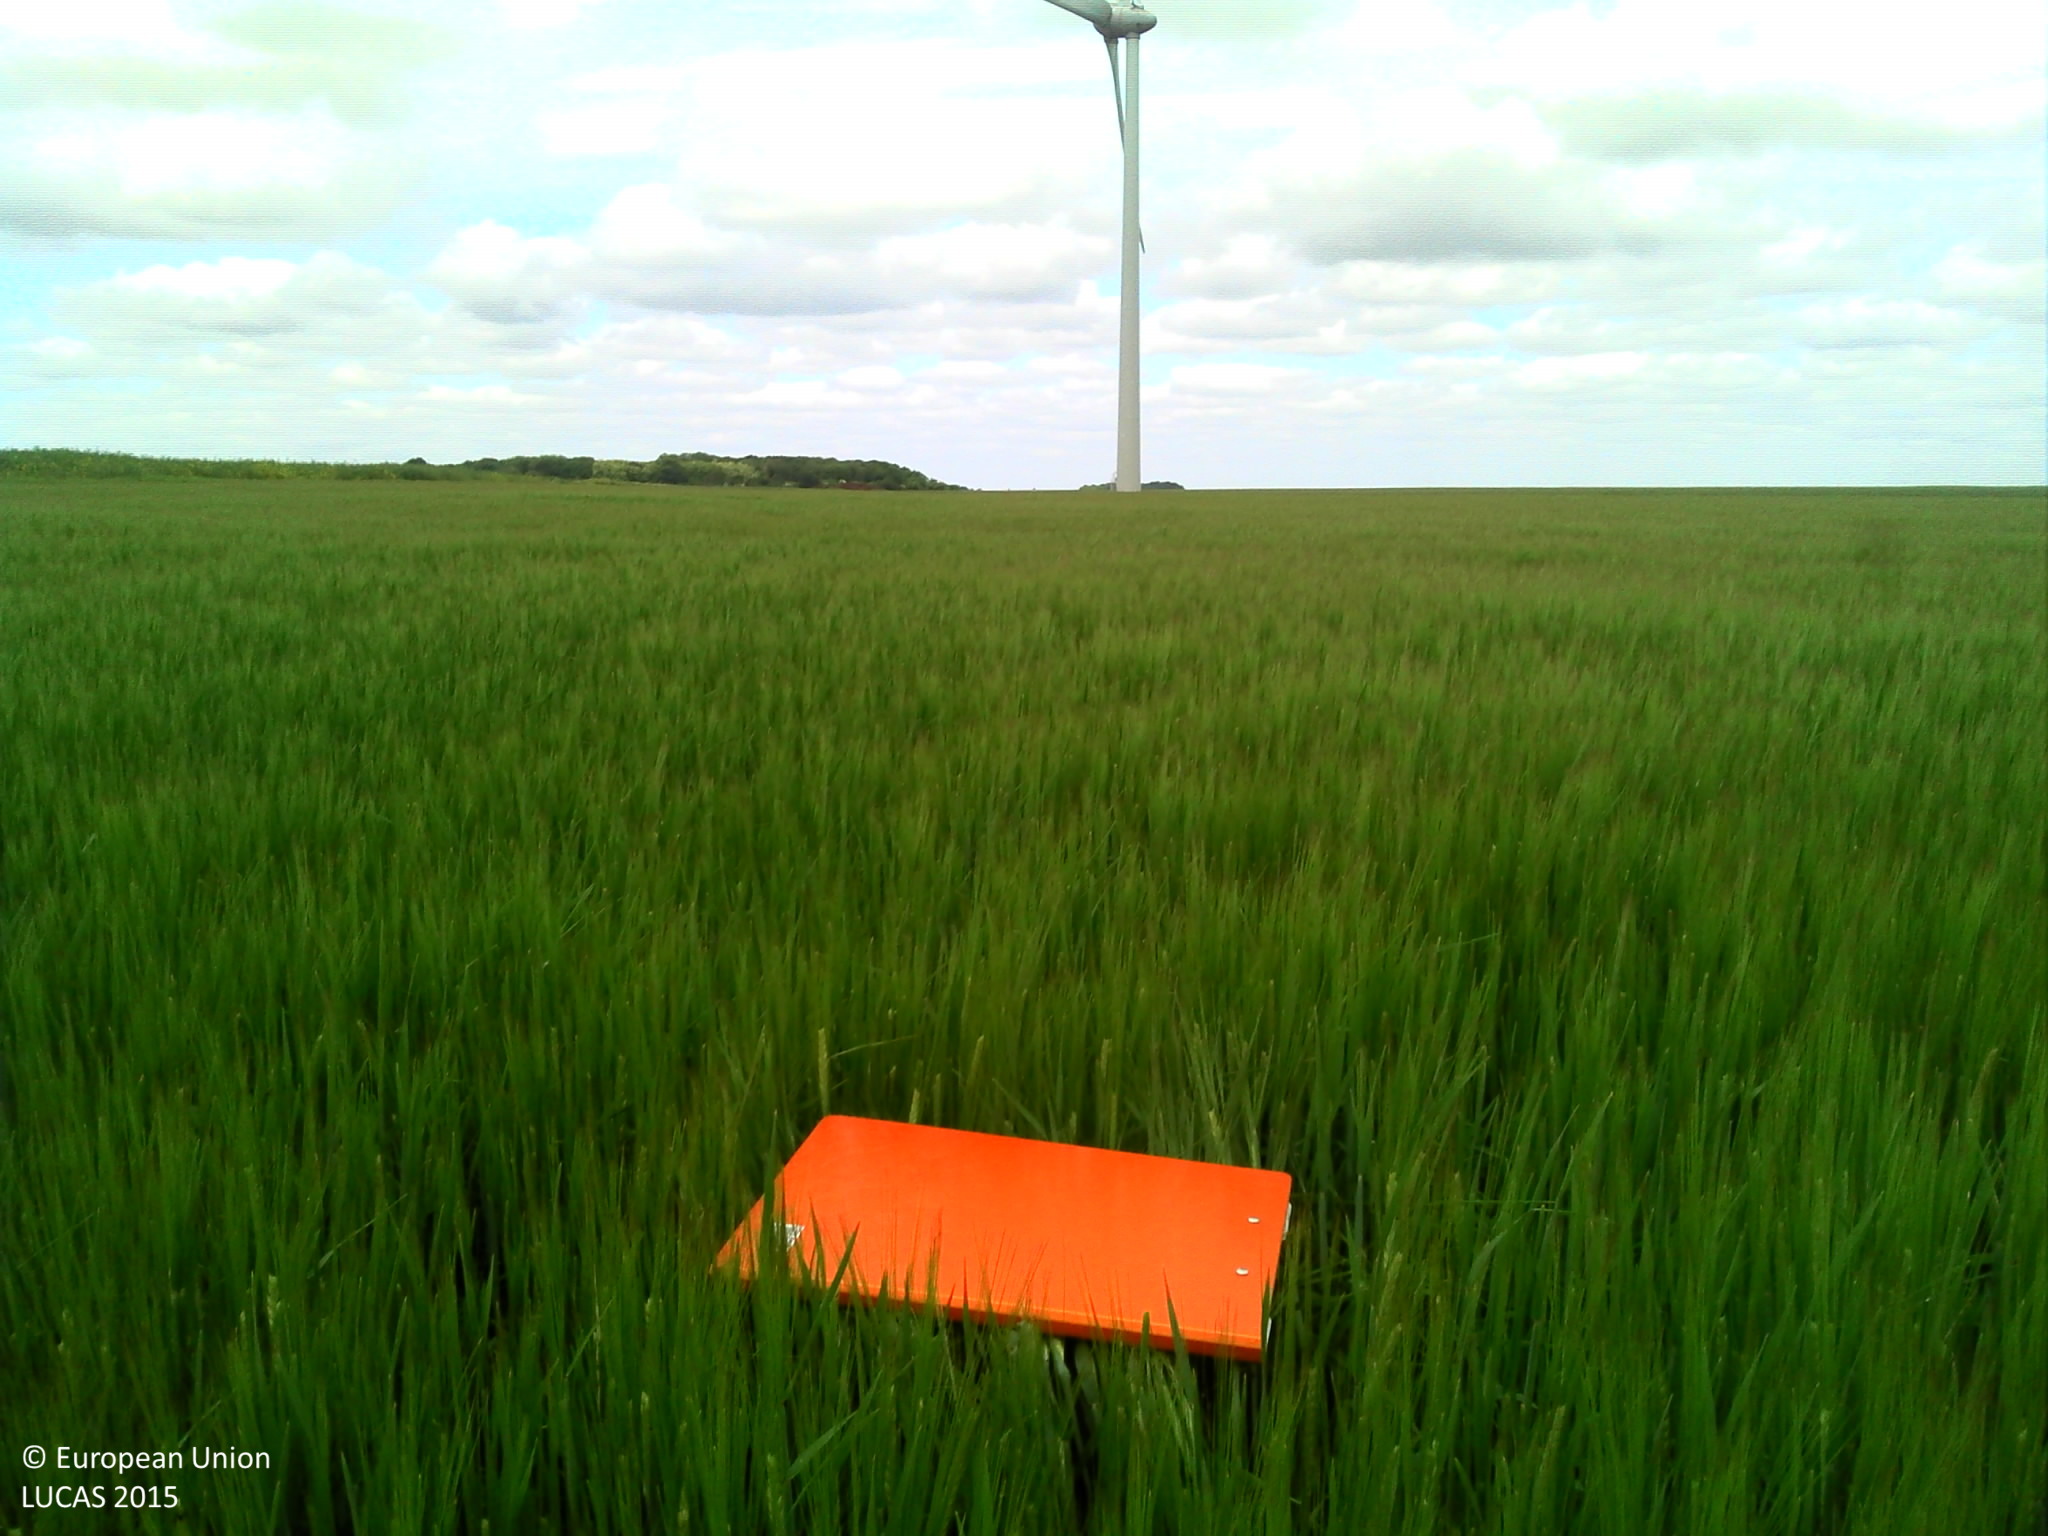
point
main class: Cropland
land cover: Barley
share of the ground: > 75 %
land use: Agriculture (excluding fallow land and kitchen gardens)
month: June
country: FR
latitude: 48.3811
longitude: 1.9527
